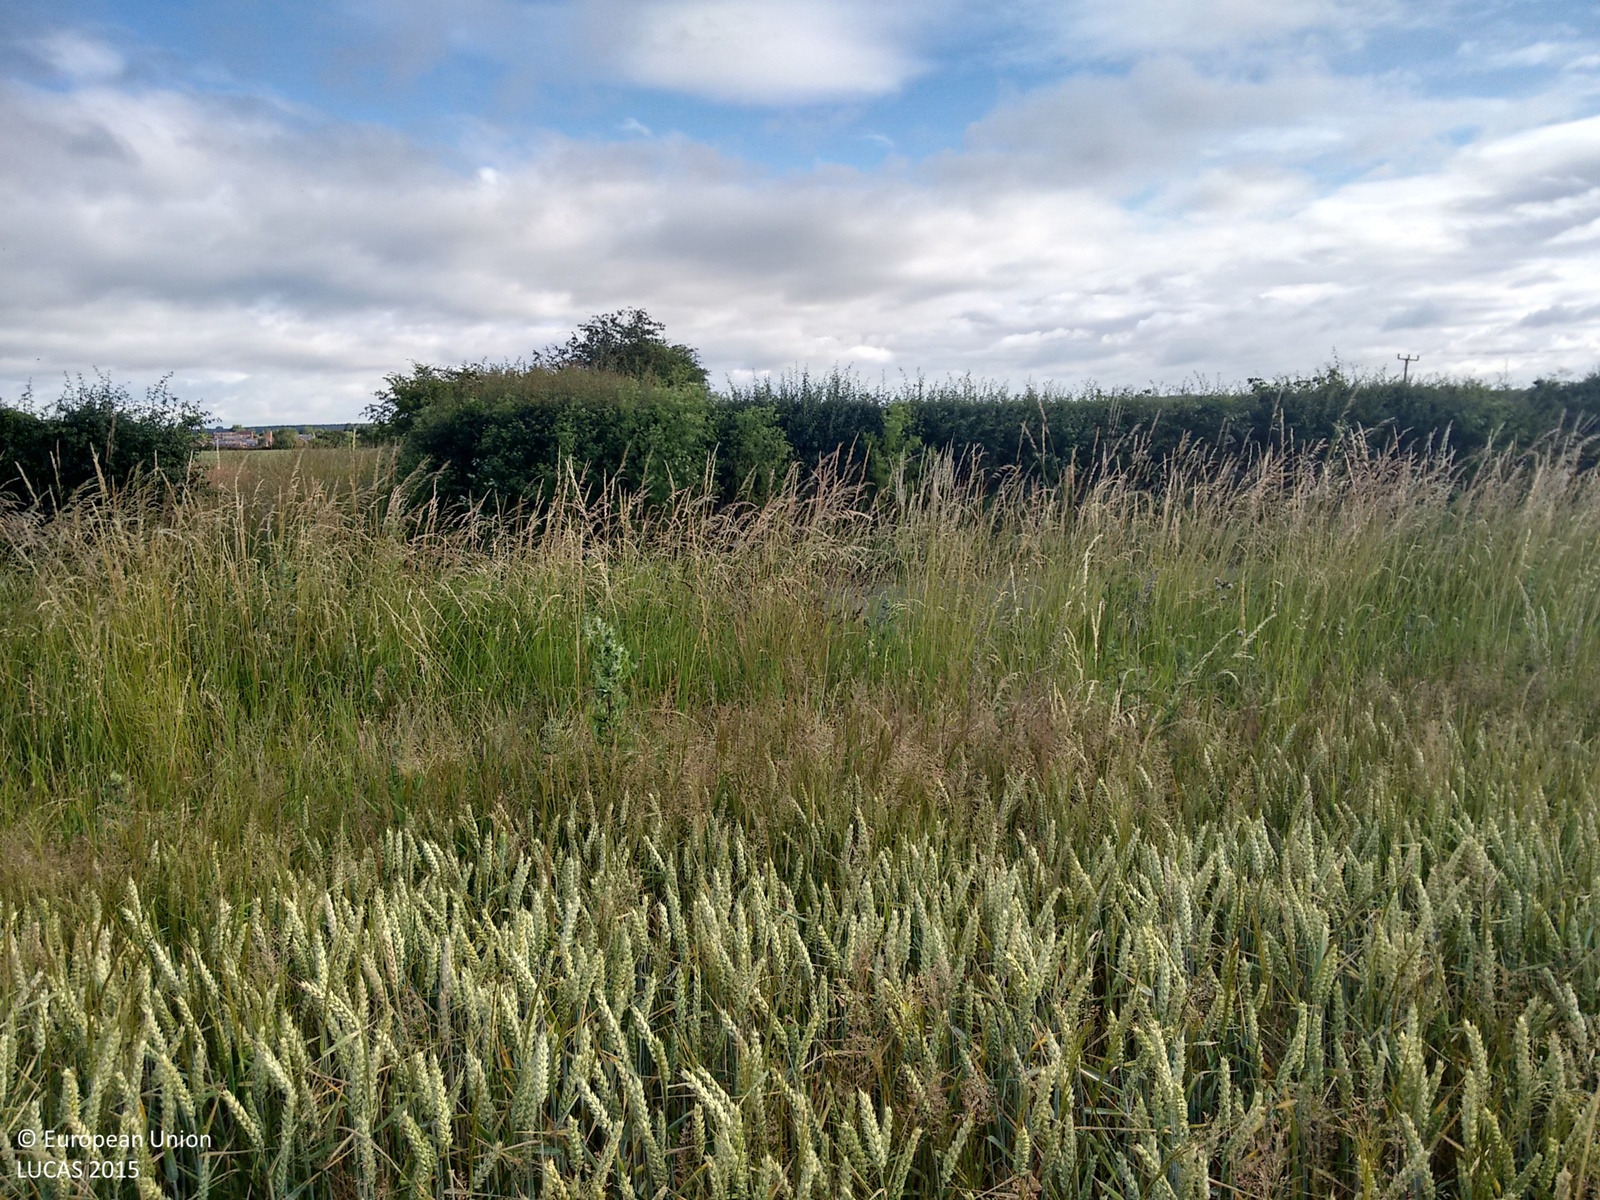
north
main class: Cropland
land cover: Common wheat
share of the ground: > 75 %
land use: Agriculture (excluding fallow land and kitchen gardens)
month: July
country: GB
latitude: 53.3915
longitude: -0.9751
